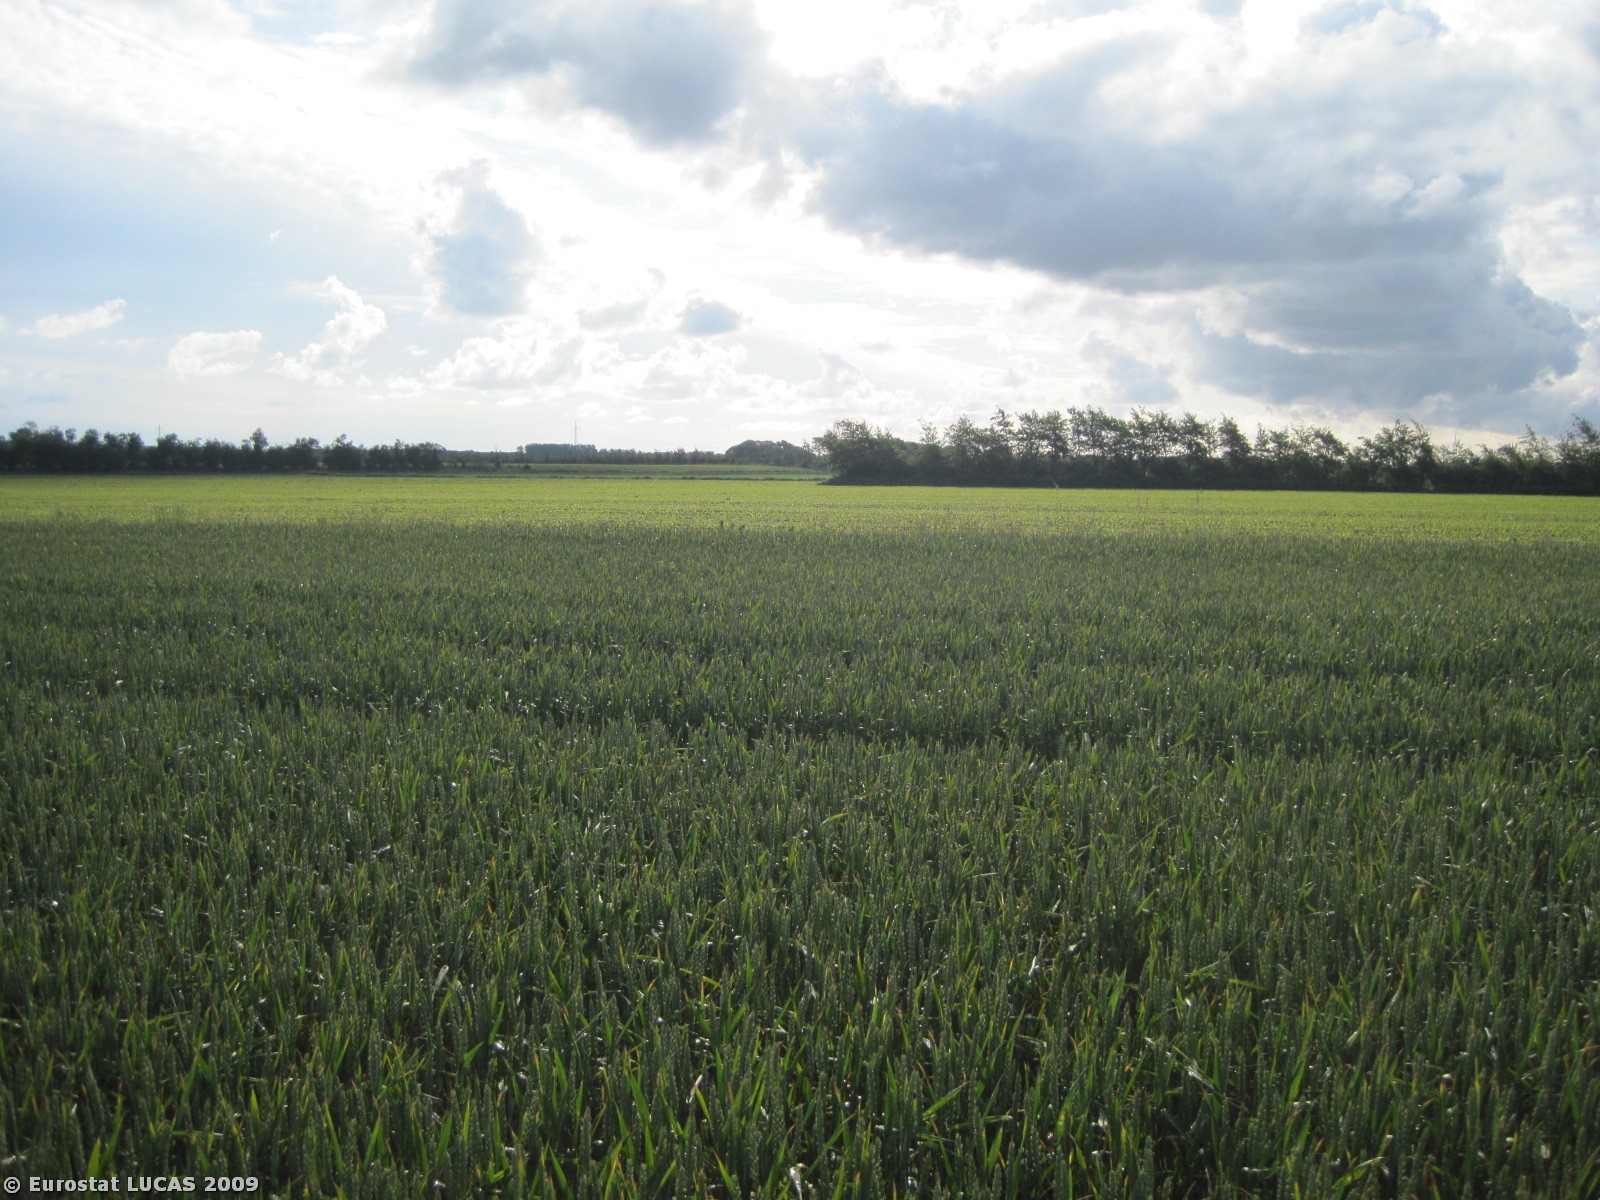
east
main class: Cropland
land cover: Common wheat
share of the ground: > 75 %
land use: Agriculture (excluding fallow land and kitchen gardens)
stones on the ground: < 10 %
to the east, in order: Common wheat; Grass margins; Ditches and canals; Grass margins; Maize; Grass margins; Broadleaved woodland; Rye; Grass margins; Maize
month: June
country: DK
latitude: 57.0686
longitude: 10.0823
